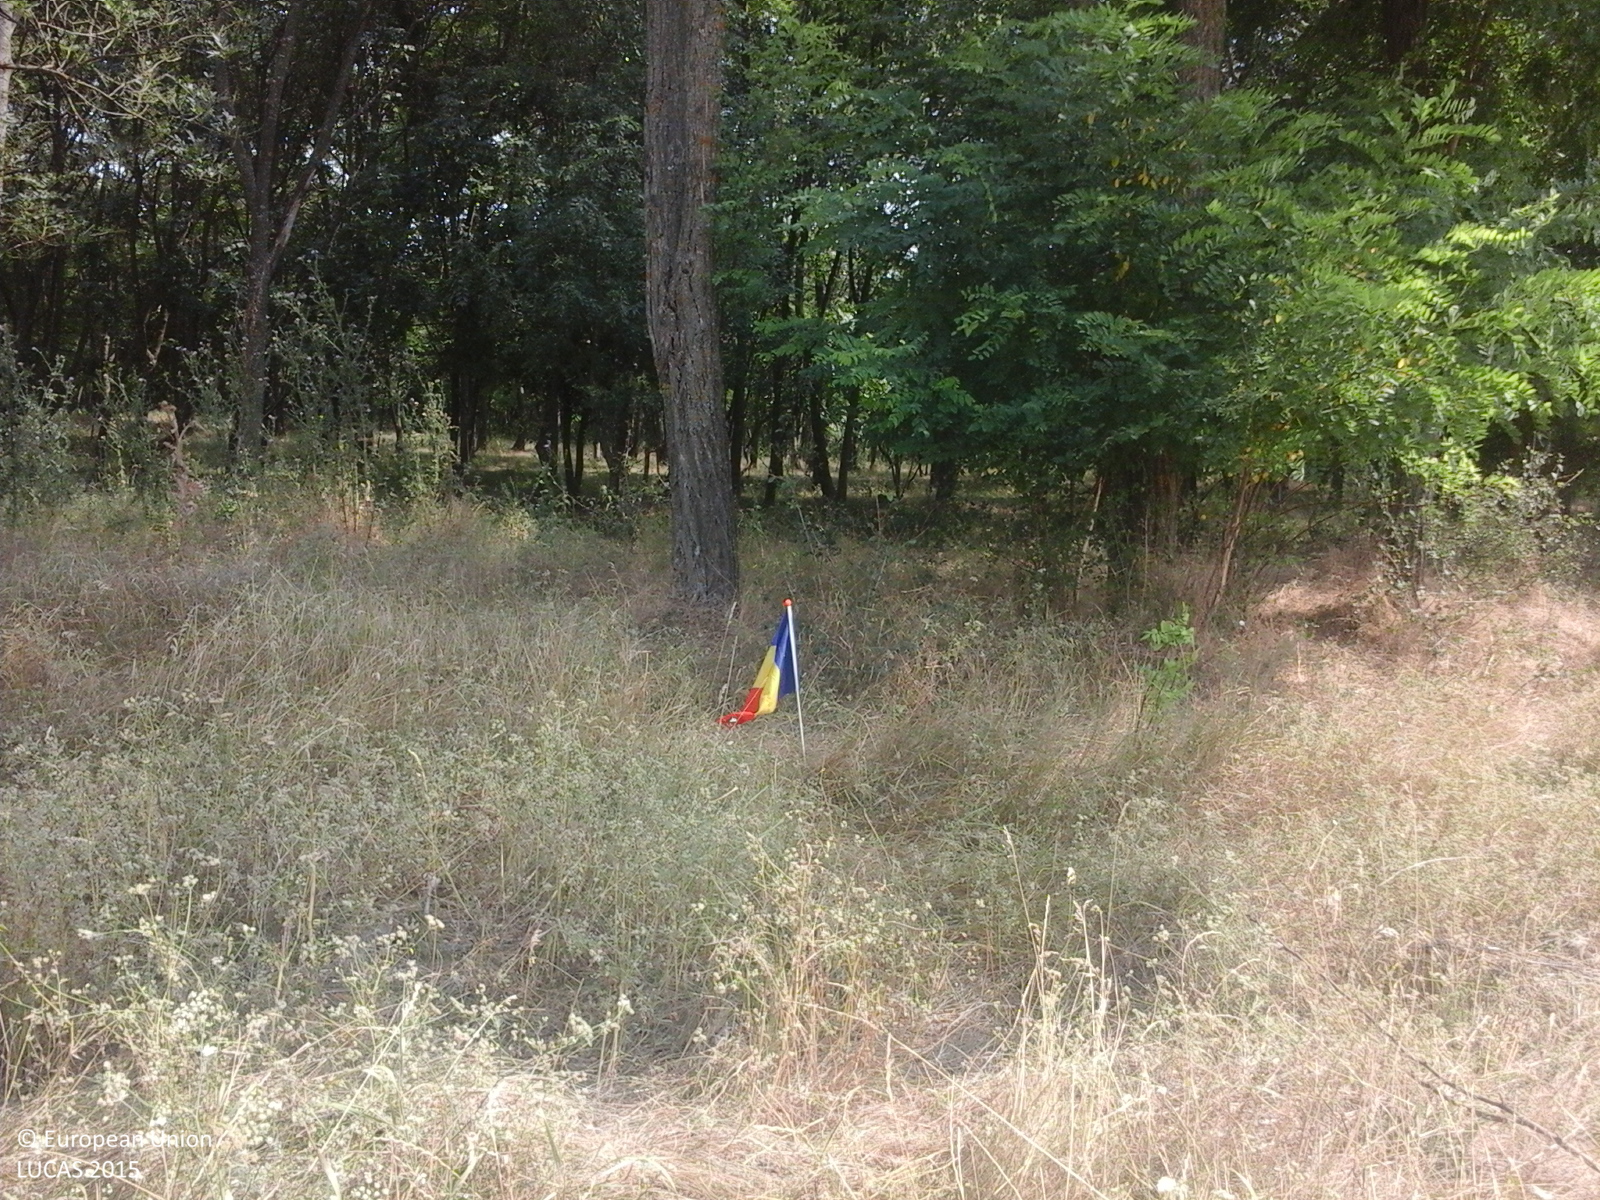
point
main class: Woodland
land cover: Broadleaved woodland
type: mesophytic deciduous forest
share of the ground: > 75 %
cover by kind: broadleaved forest trees 85 %, herbaceous plants 15 %
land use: Forestry
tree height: > 5 m
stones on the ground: 10 - 25 %
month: July
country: RO
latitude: 44.9816
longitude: 28.3737
